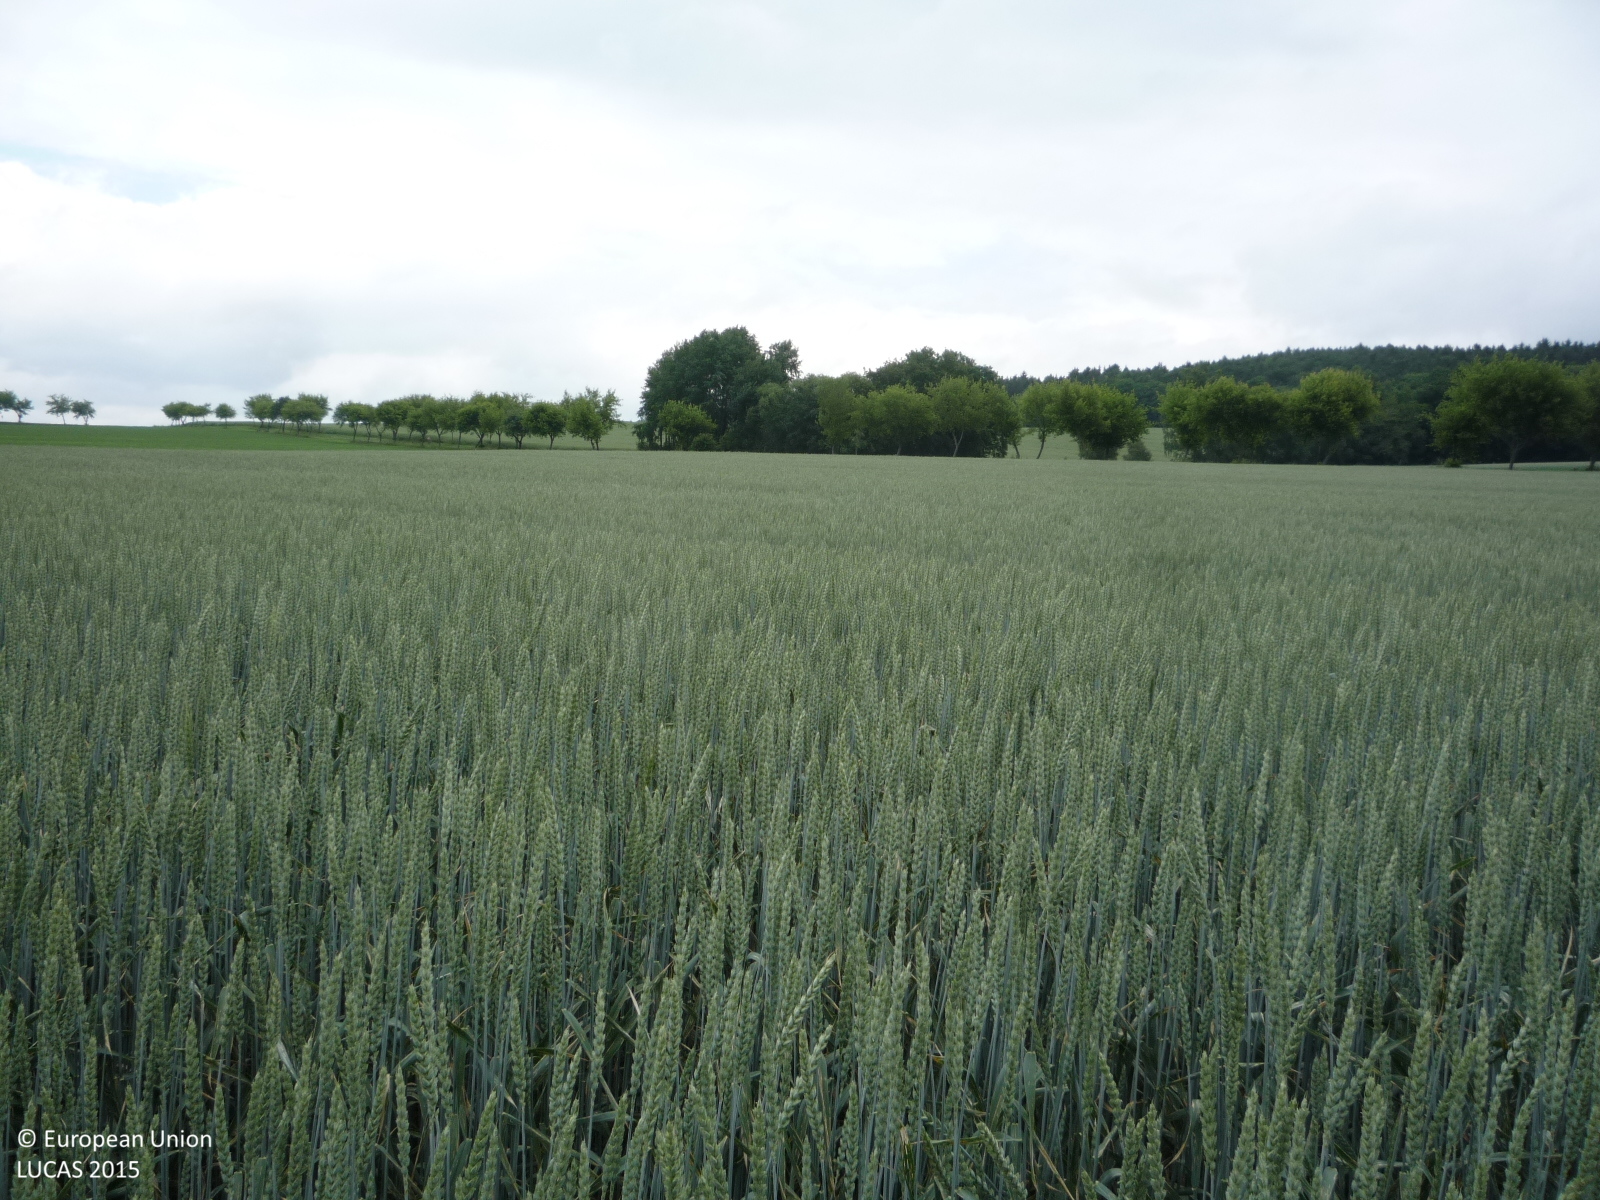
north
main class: Cropland
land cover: Common wheat
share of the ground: > 75 %
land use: Agriculture (excluding fallow land and kitchen gardens)
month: June
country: CZ
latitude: 49.8060
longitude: 14.9631
